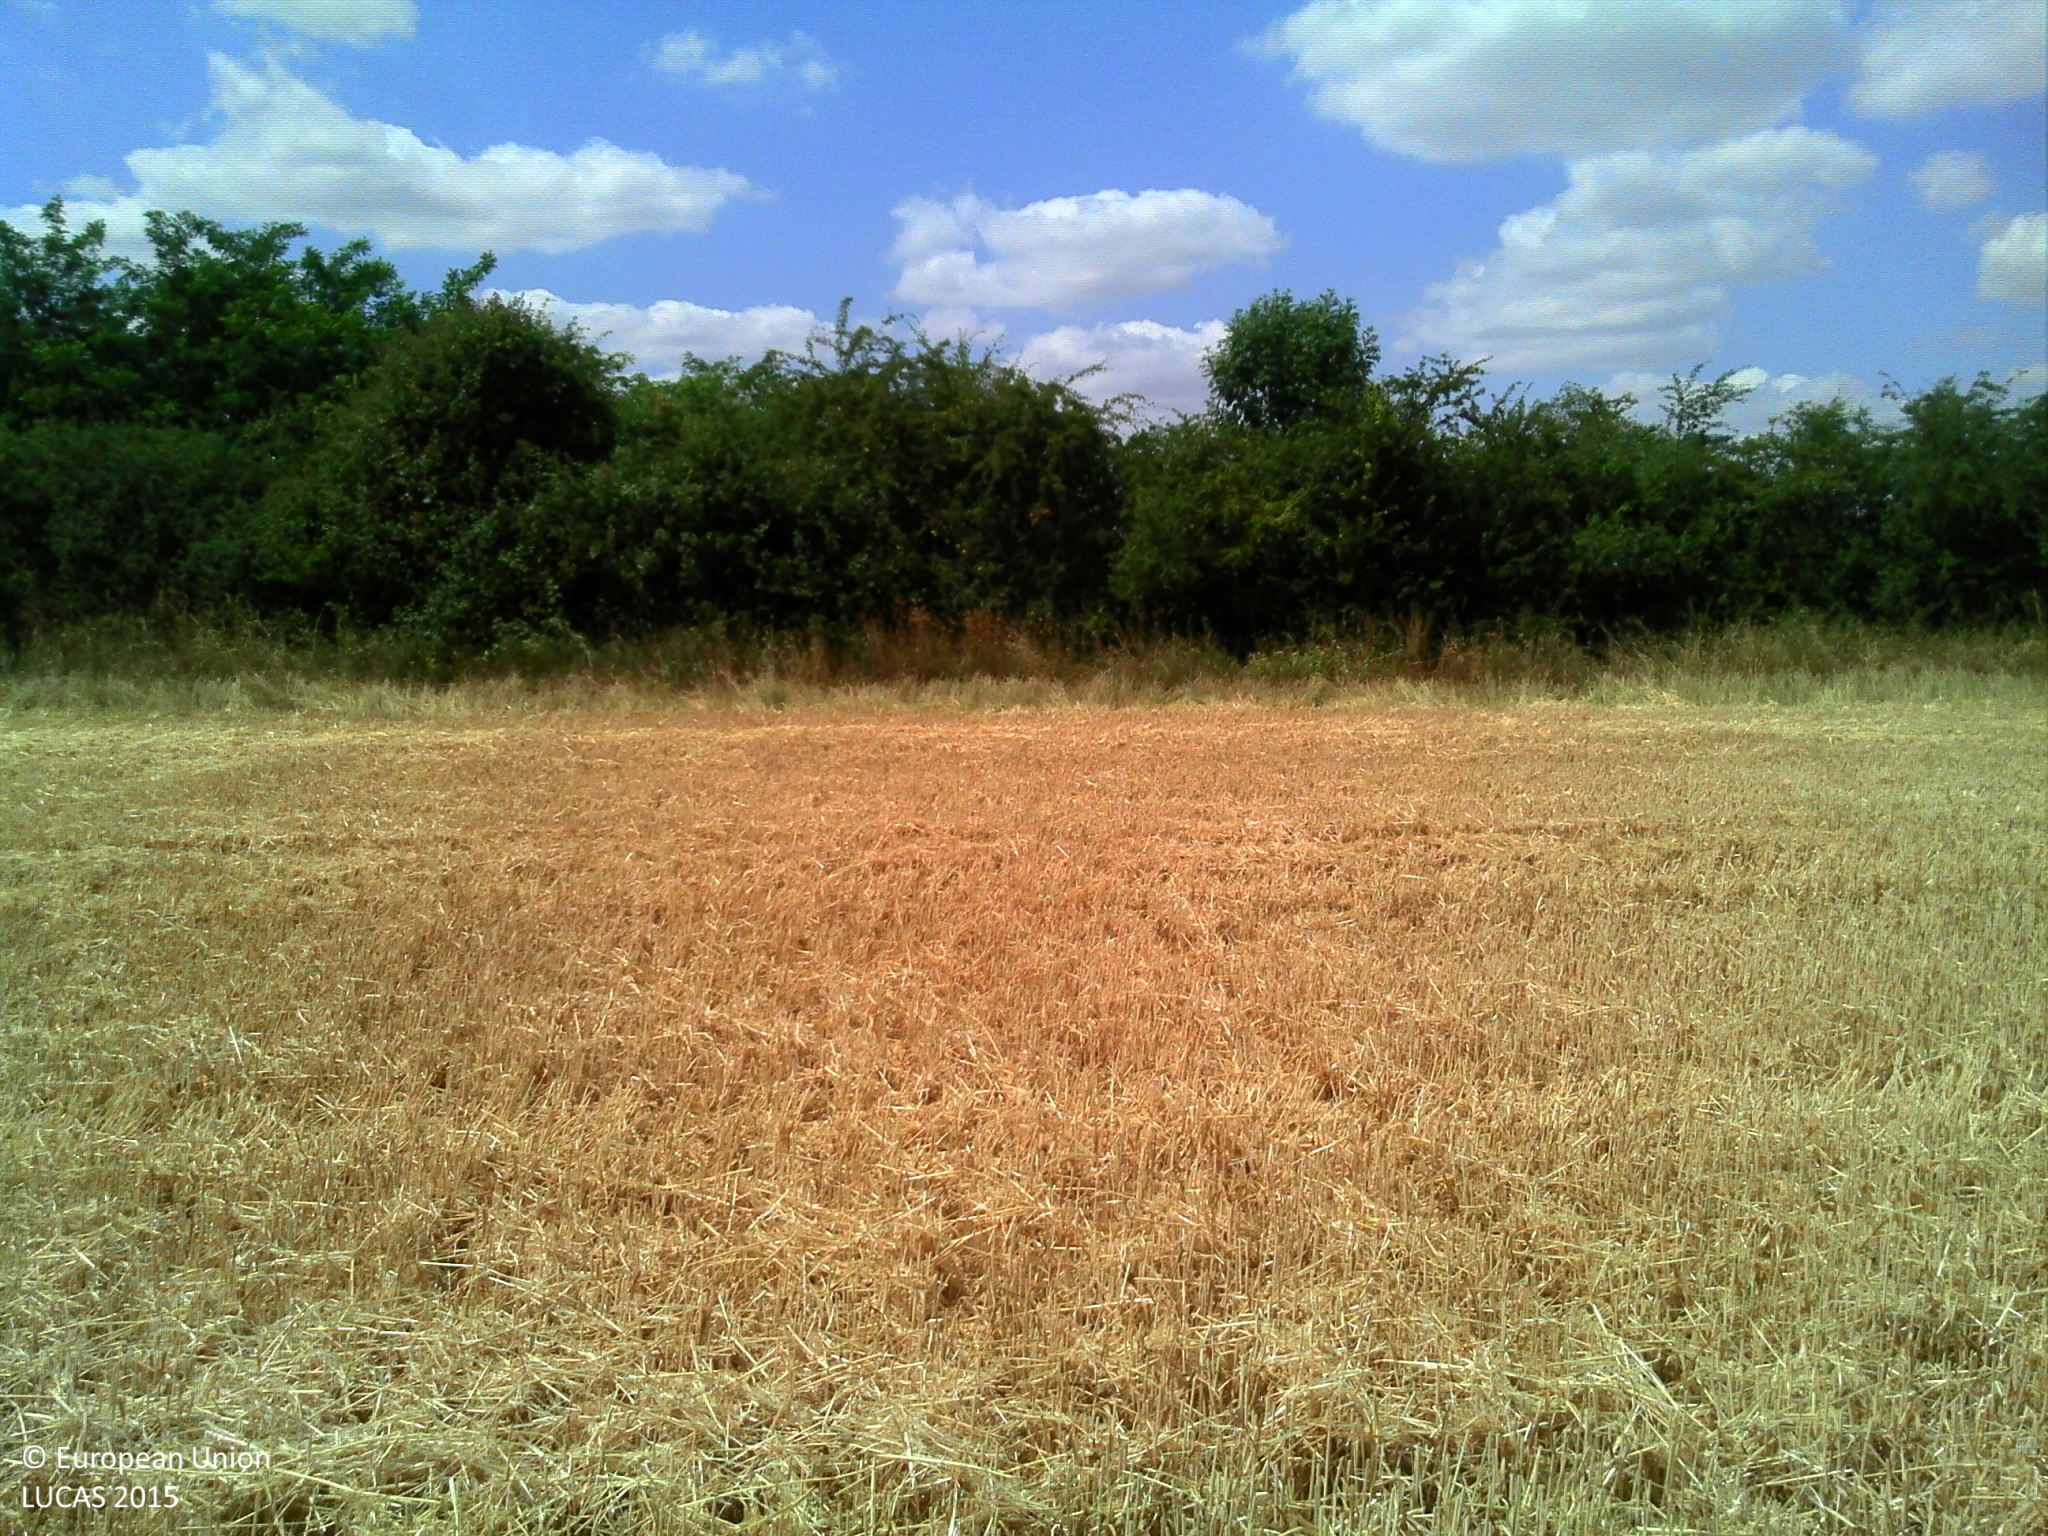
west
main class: Cropland
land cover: Common wheat
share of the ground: > 75 %
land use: Agriculture (excluding fallow land and kitchen gardens)
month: July
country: FR
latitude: 48.0933
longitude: 2.4846
